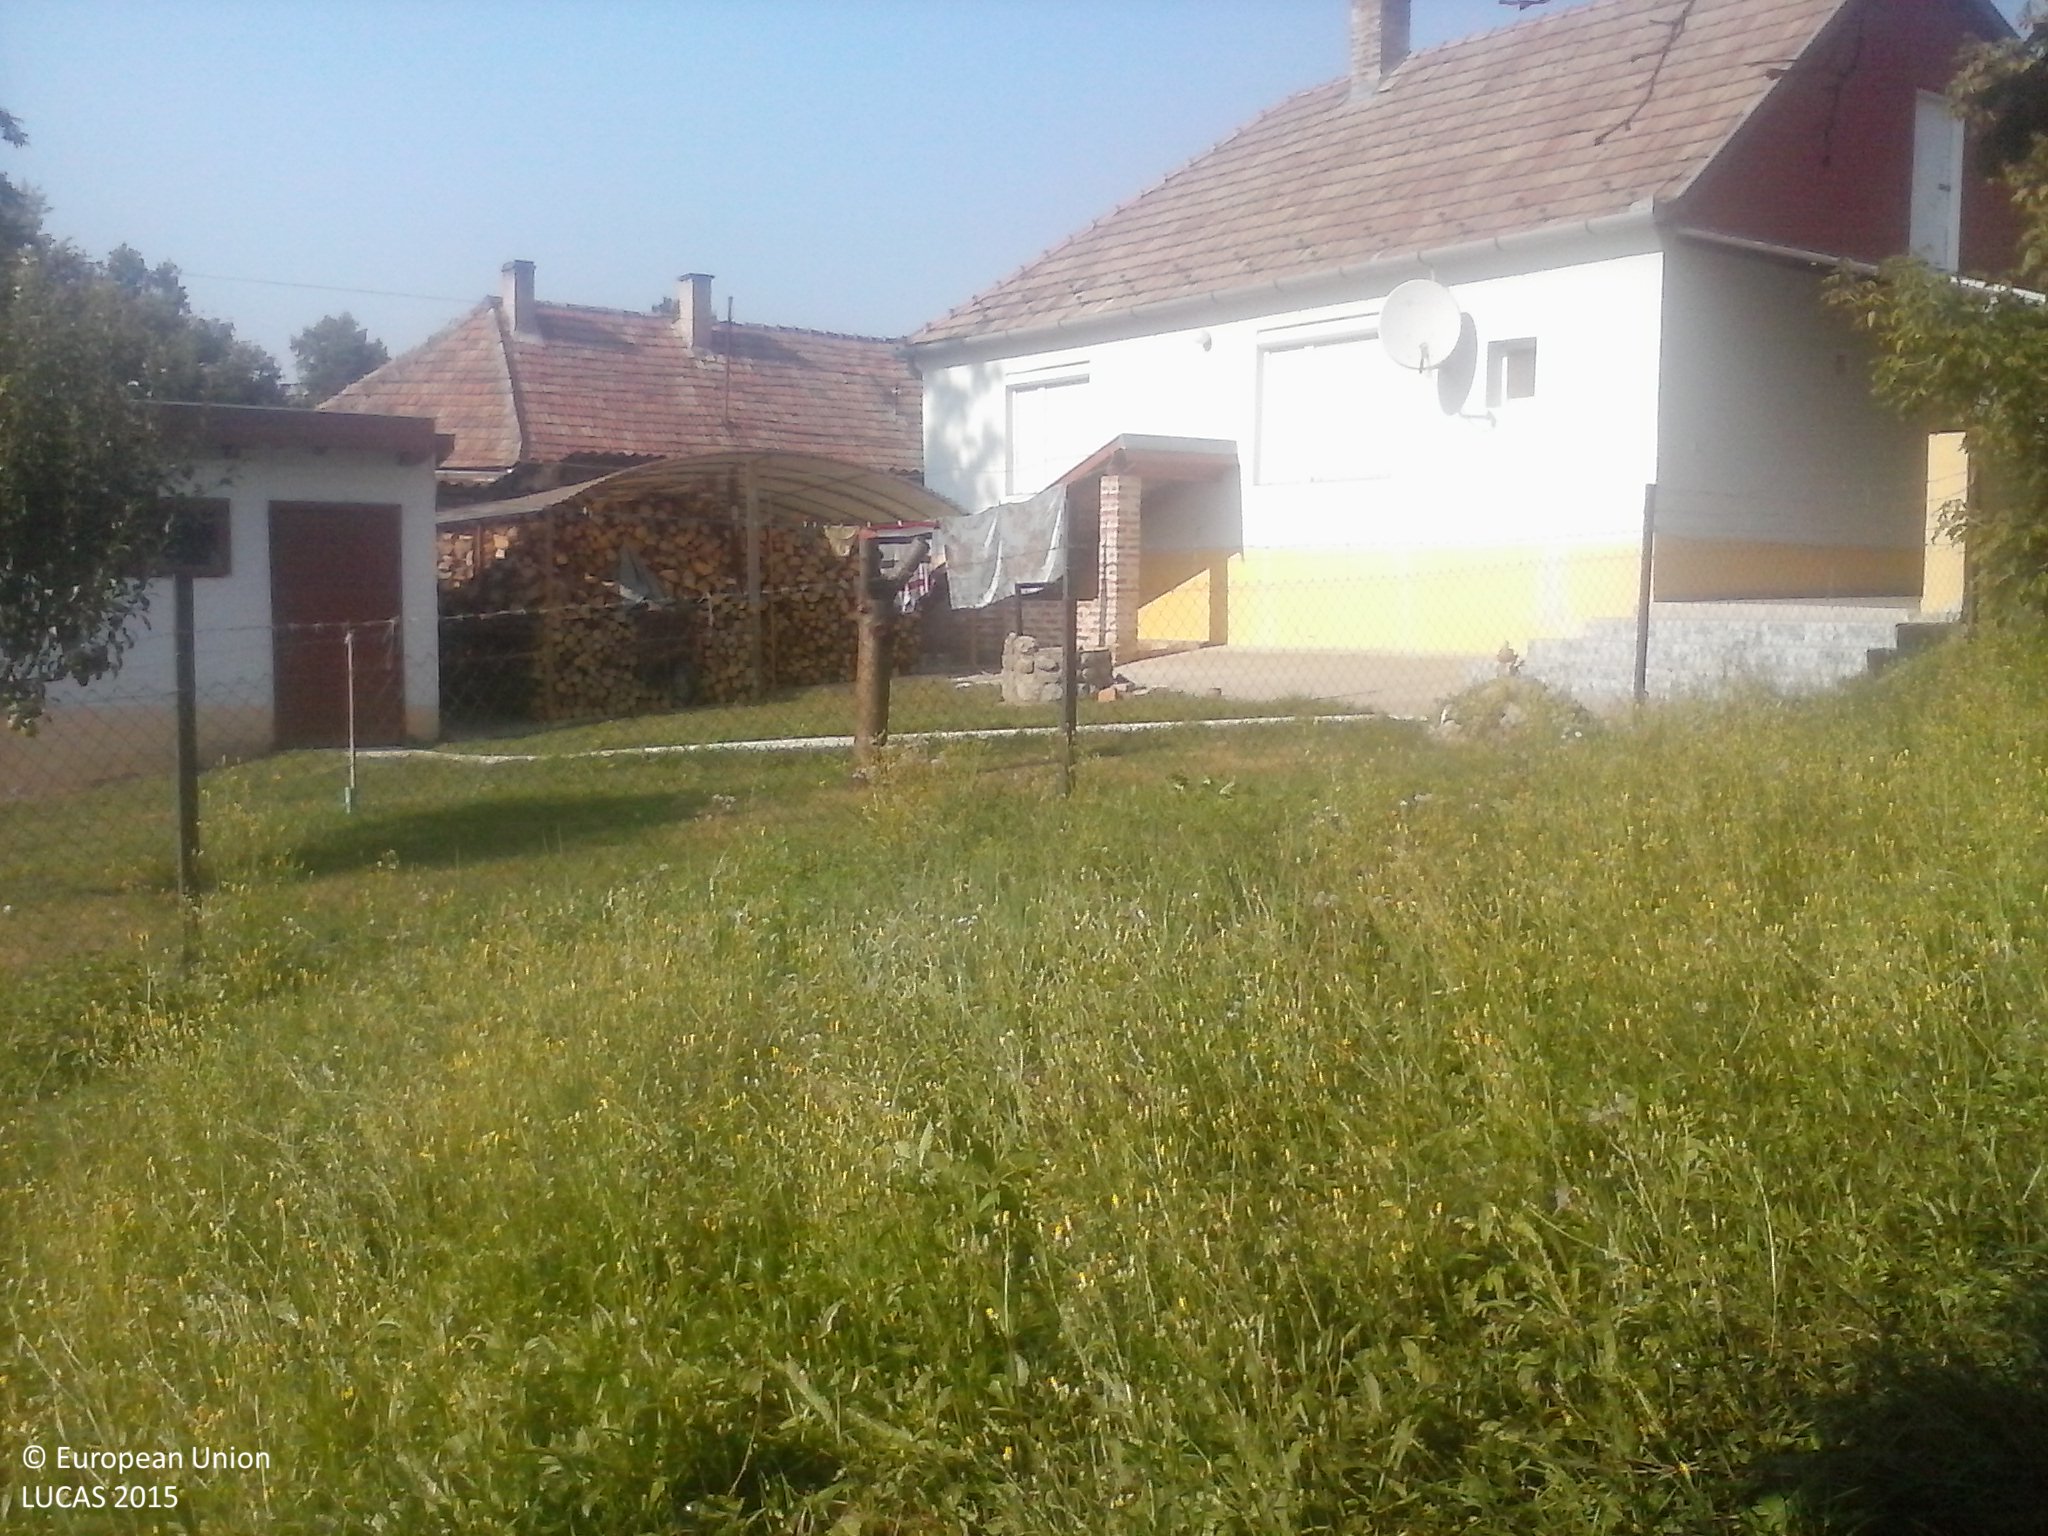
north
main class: Grassland
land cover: Grassland with sparse tree/shrub cover
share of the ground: > 75 %
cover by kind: herbaceous plants 90 %, broadleaved forest trees 5 %, shrubs 5 %
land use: Residential
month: August
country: HU
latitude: 46.0482
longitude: 17.7978
